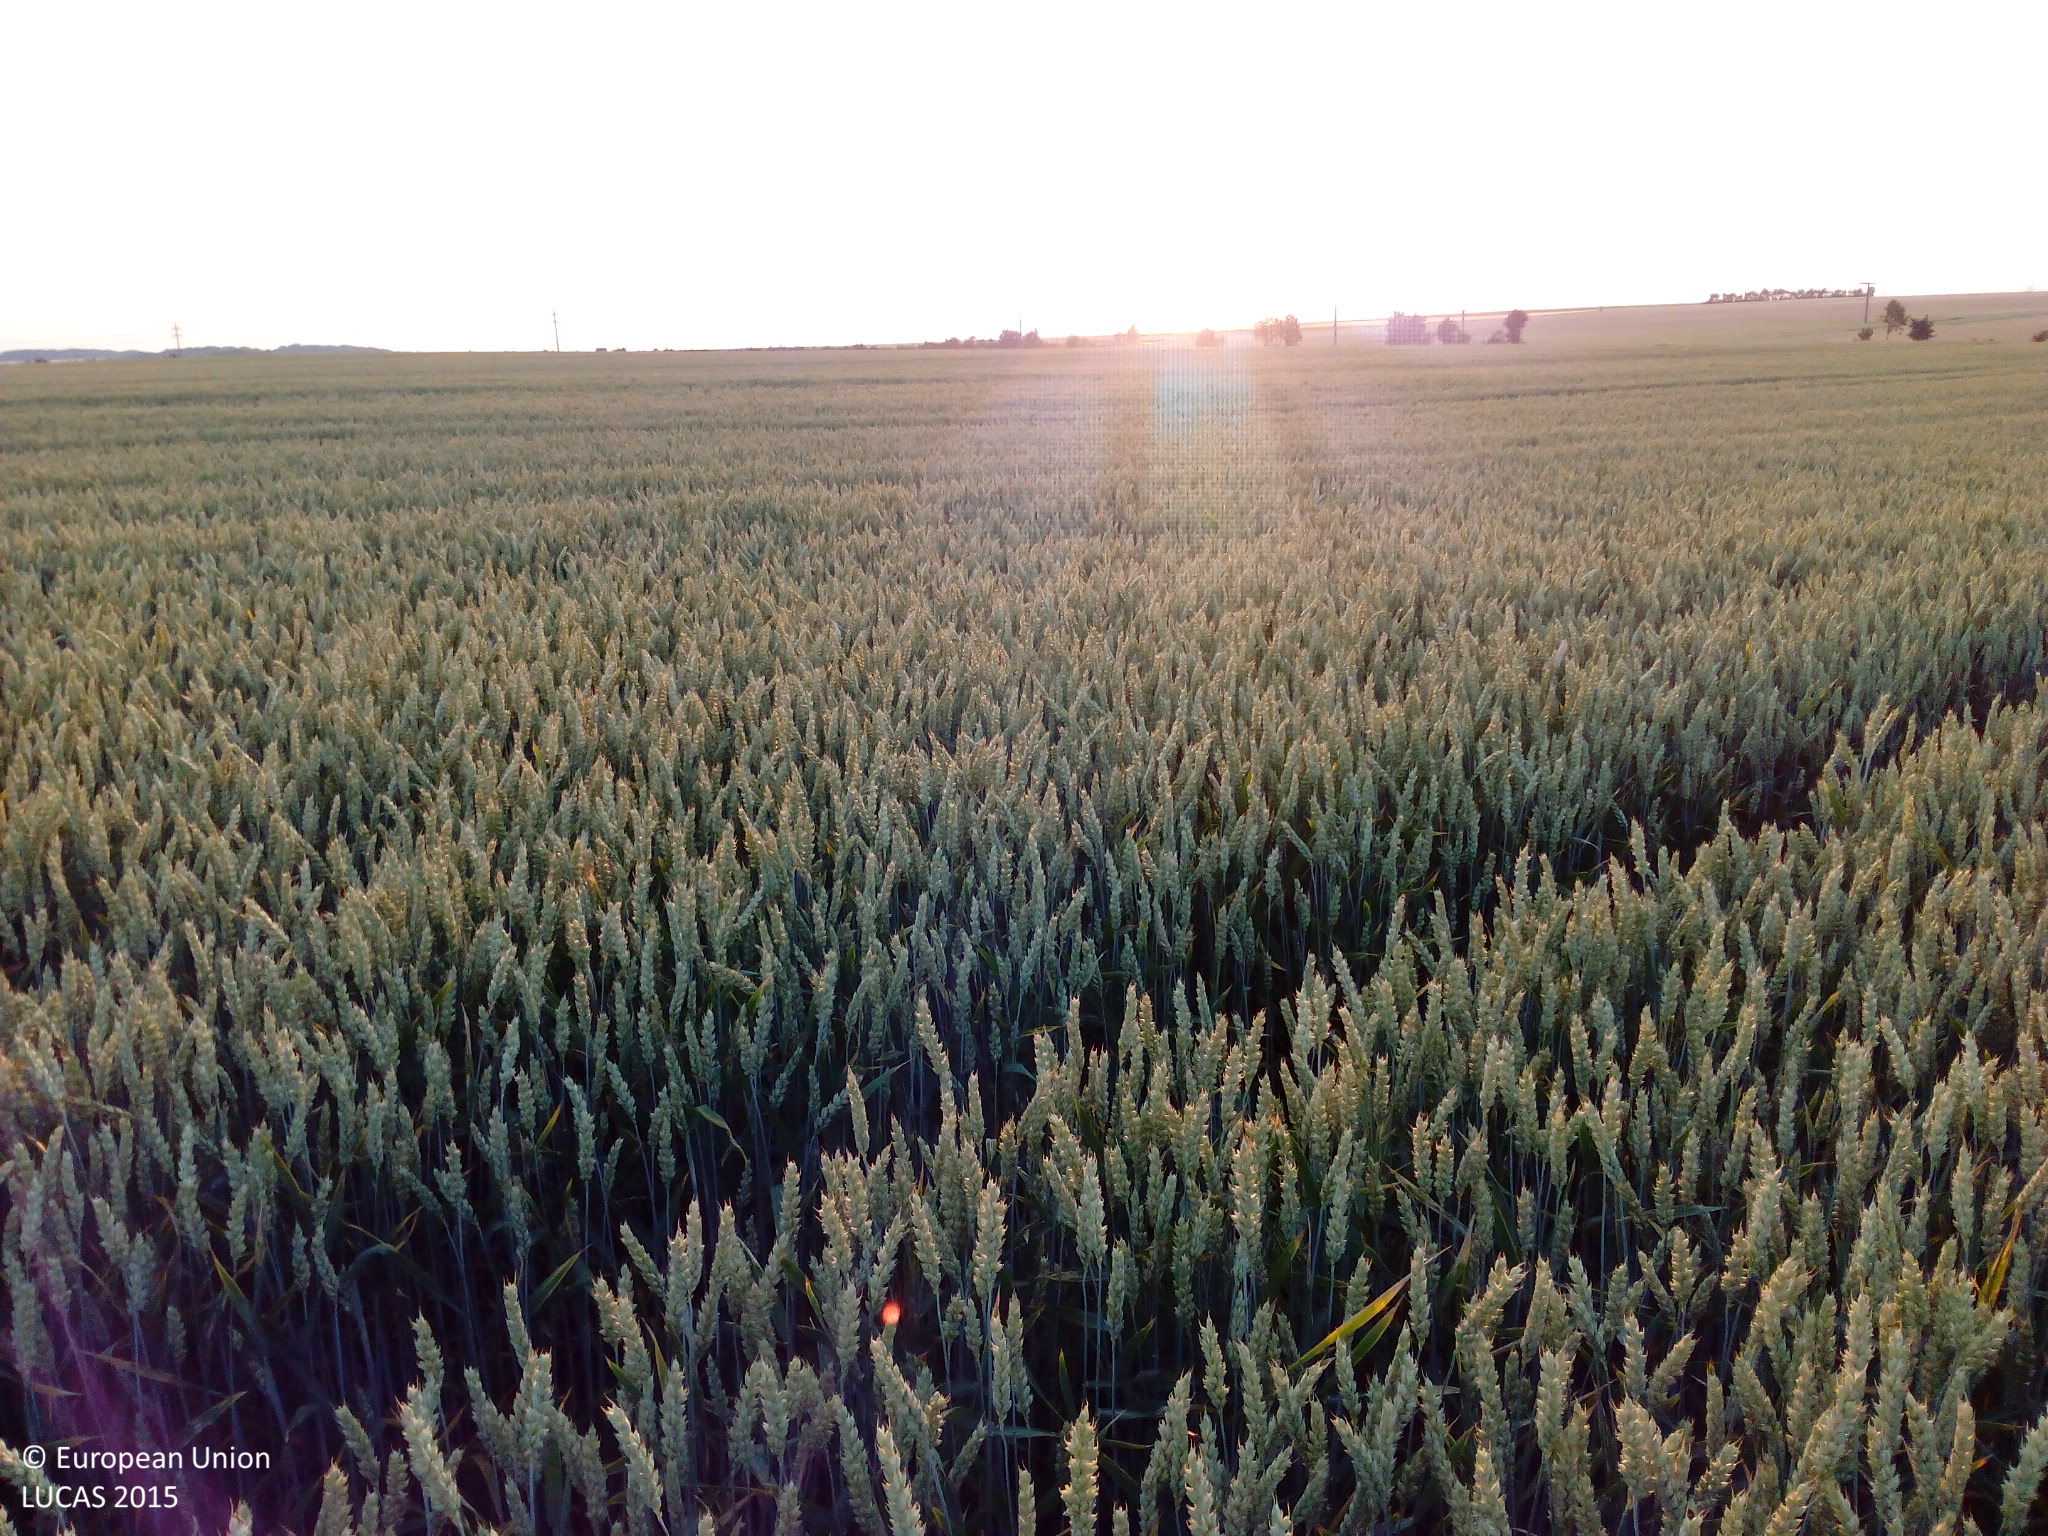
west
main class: Cropland
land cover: Common wheat
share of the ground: > 75 %
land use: Agriculture (excluding fallow land and kitchen gardens)
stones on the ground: < 10 %
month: July
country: DE
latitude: 49.5908
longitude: 9.9585
